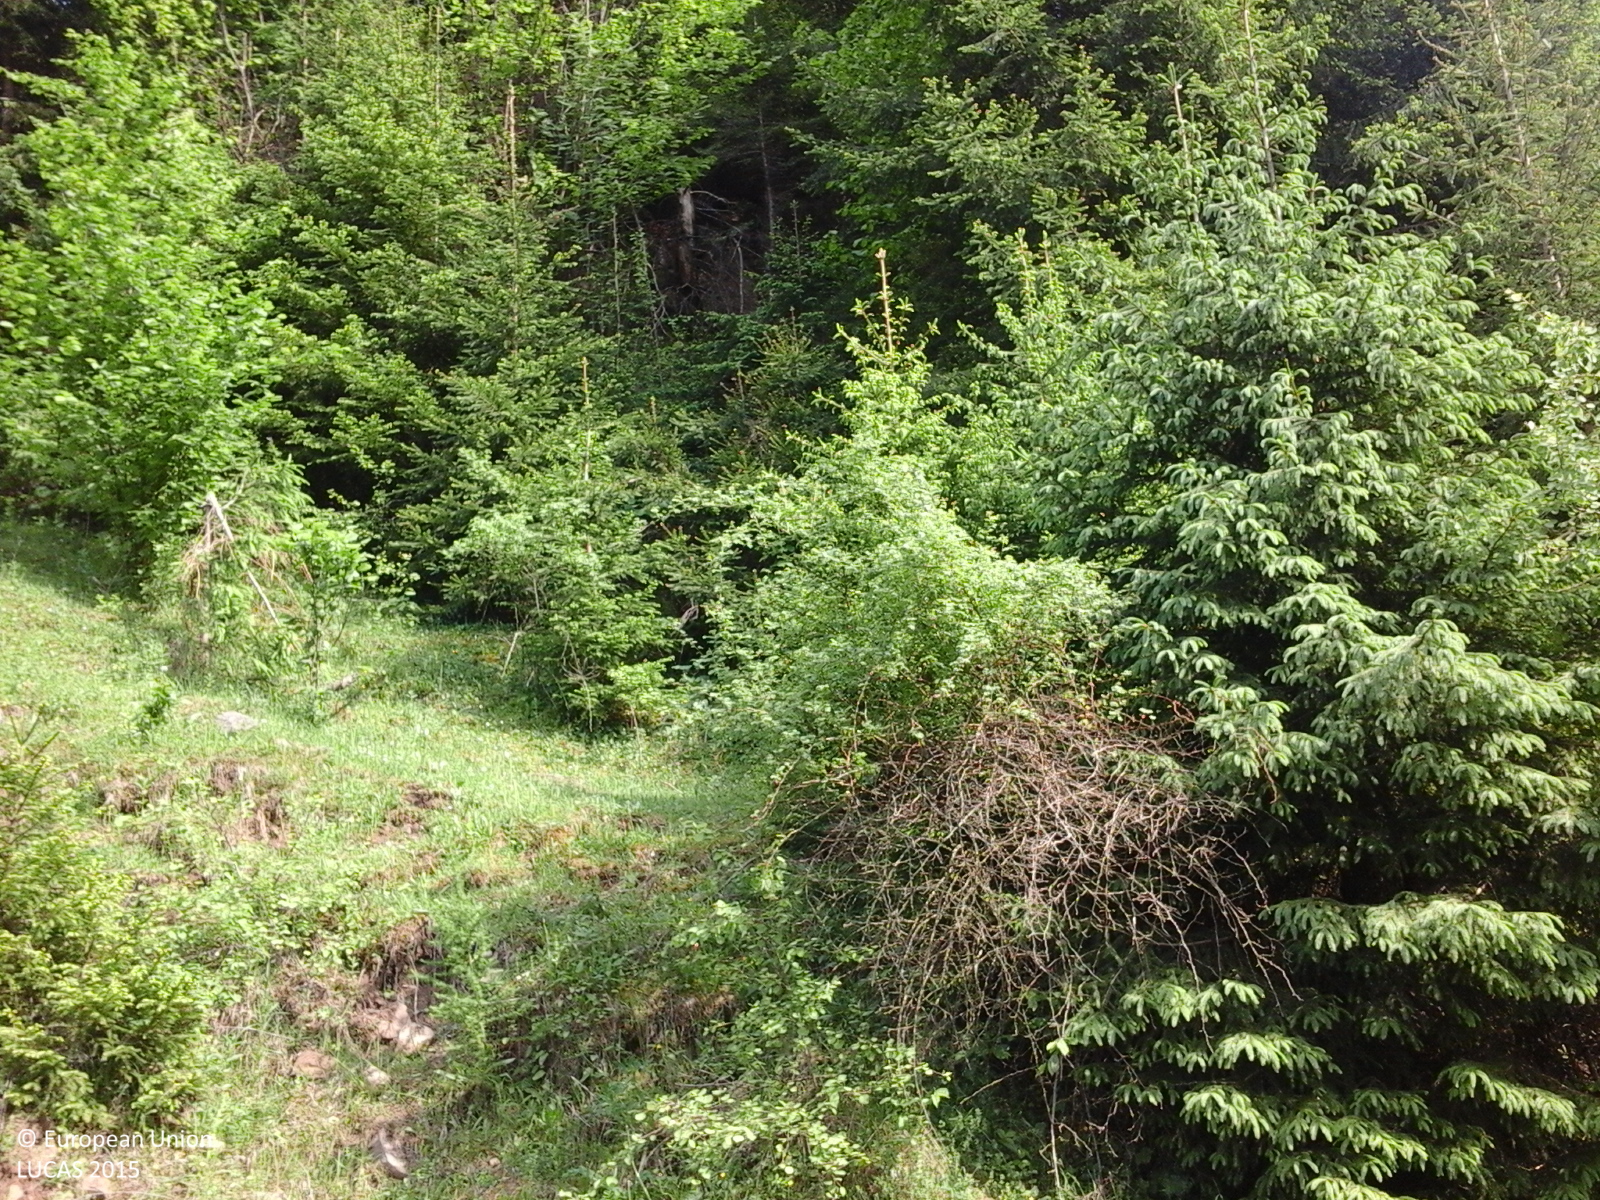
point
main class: Woodland
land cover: Spruce dominated coniferous woodland
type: alpine coniferous forest
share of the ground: > 75 %
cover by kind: coniferous forest trees 90 %, broadleaved forest trees 10 %
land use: Forestry
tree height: > 5 m
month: June
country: RO
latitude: 46.5370
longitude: 26.2038
